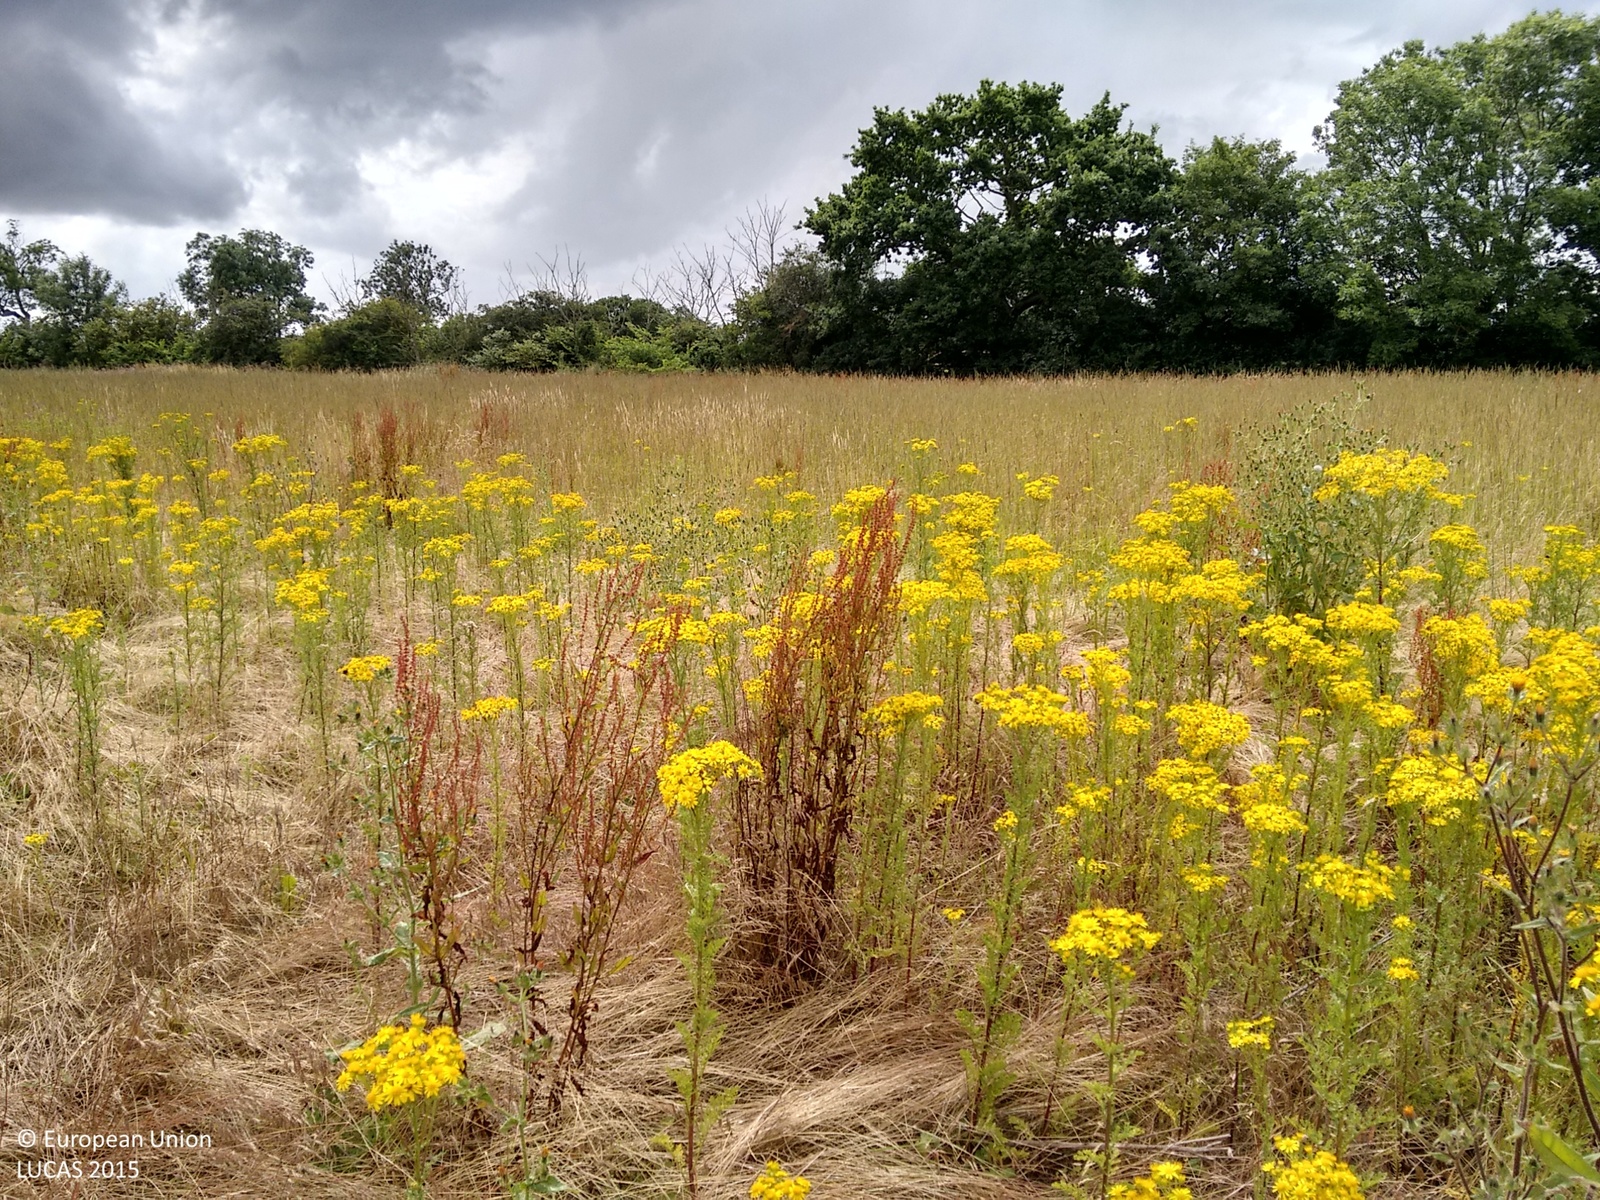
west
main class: Grassland
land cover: Spontaneously vegetated surfaces
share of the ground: > 75 %
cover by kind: herbaceous plants 100 %
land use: Fallow land
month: July
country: GB
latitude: 52.7884
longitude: -0.8218
